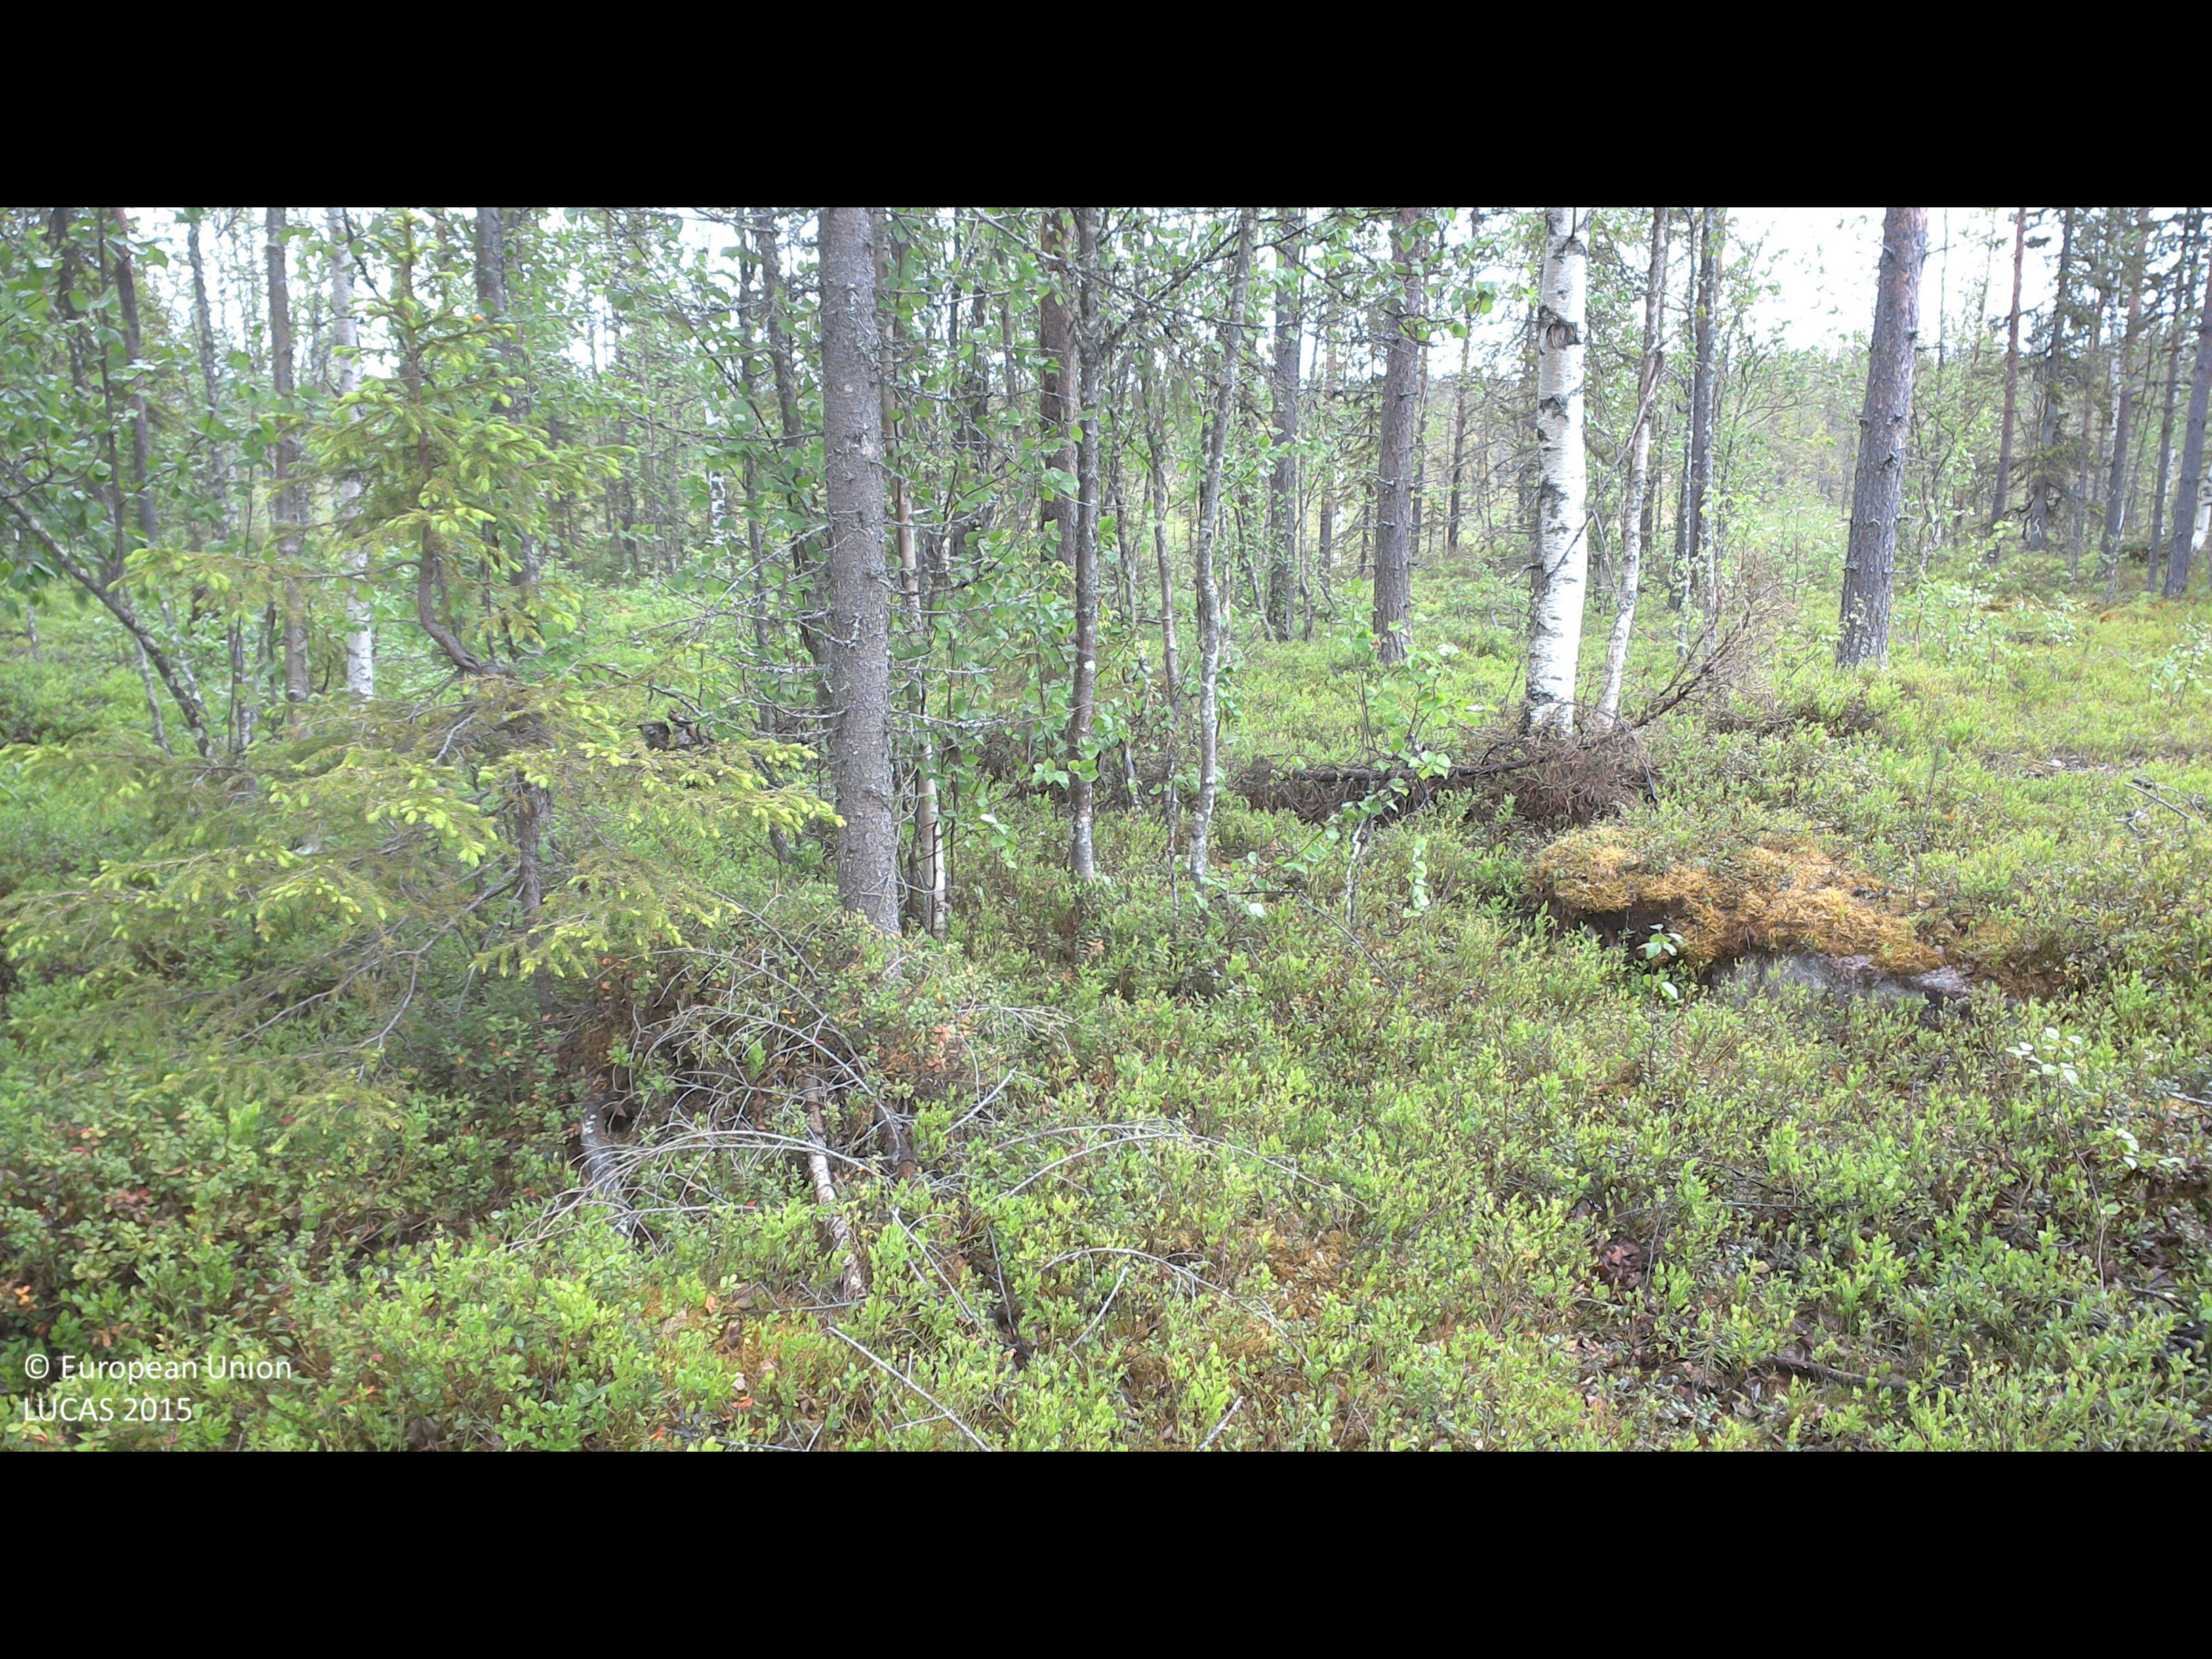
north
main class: Woodland
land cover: Pine dominated mixed woodland
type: boreal forest
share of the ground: 25 - 50 %
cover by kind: shrubs 70 %, coniferous forest trees 20 %, broadleaved forest trees 10 %
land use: Forestry
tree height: > 5 m
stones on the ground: < 10 %
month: June
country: SE
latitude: 66.8909
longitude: 22.5475
